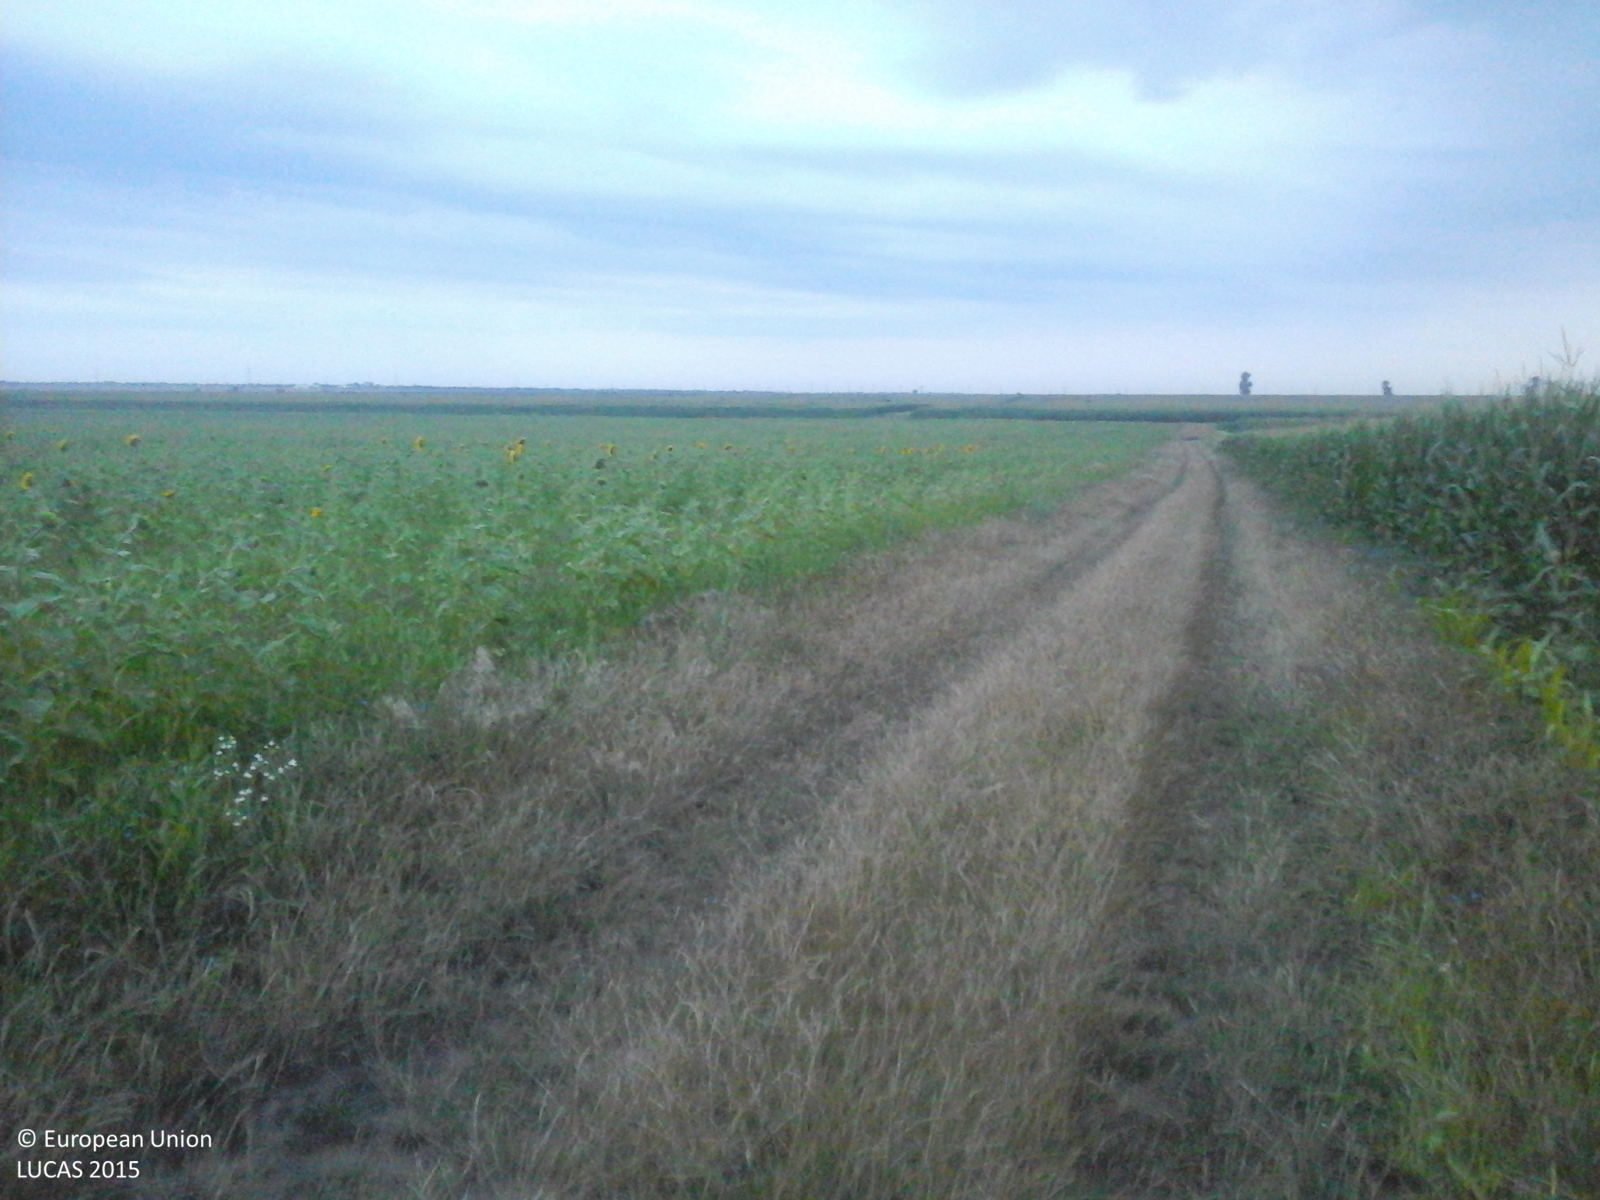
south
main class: Cropland
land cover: Maize
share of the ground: > 75 %
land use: Agriculture (excluding fallow land and kitchen gardens)
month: July
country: RO
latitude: 44.0910
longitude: 24.2641
